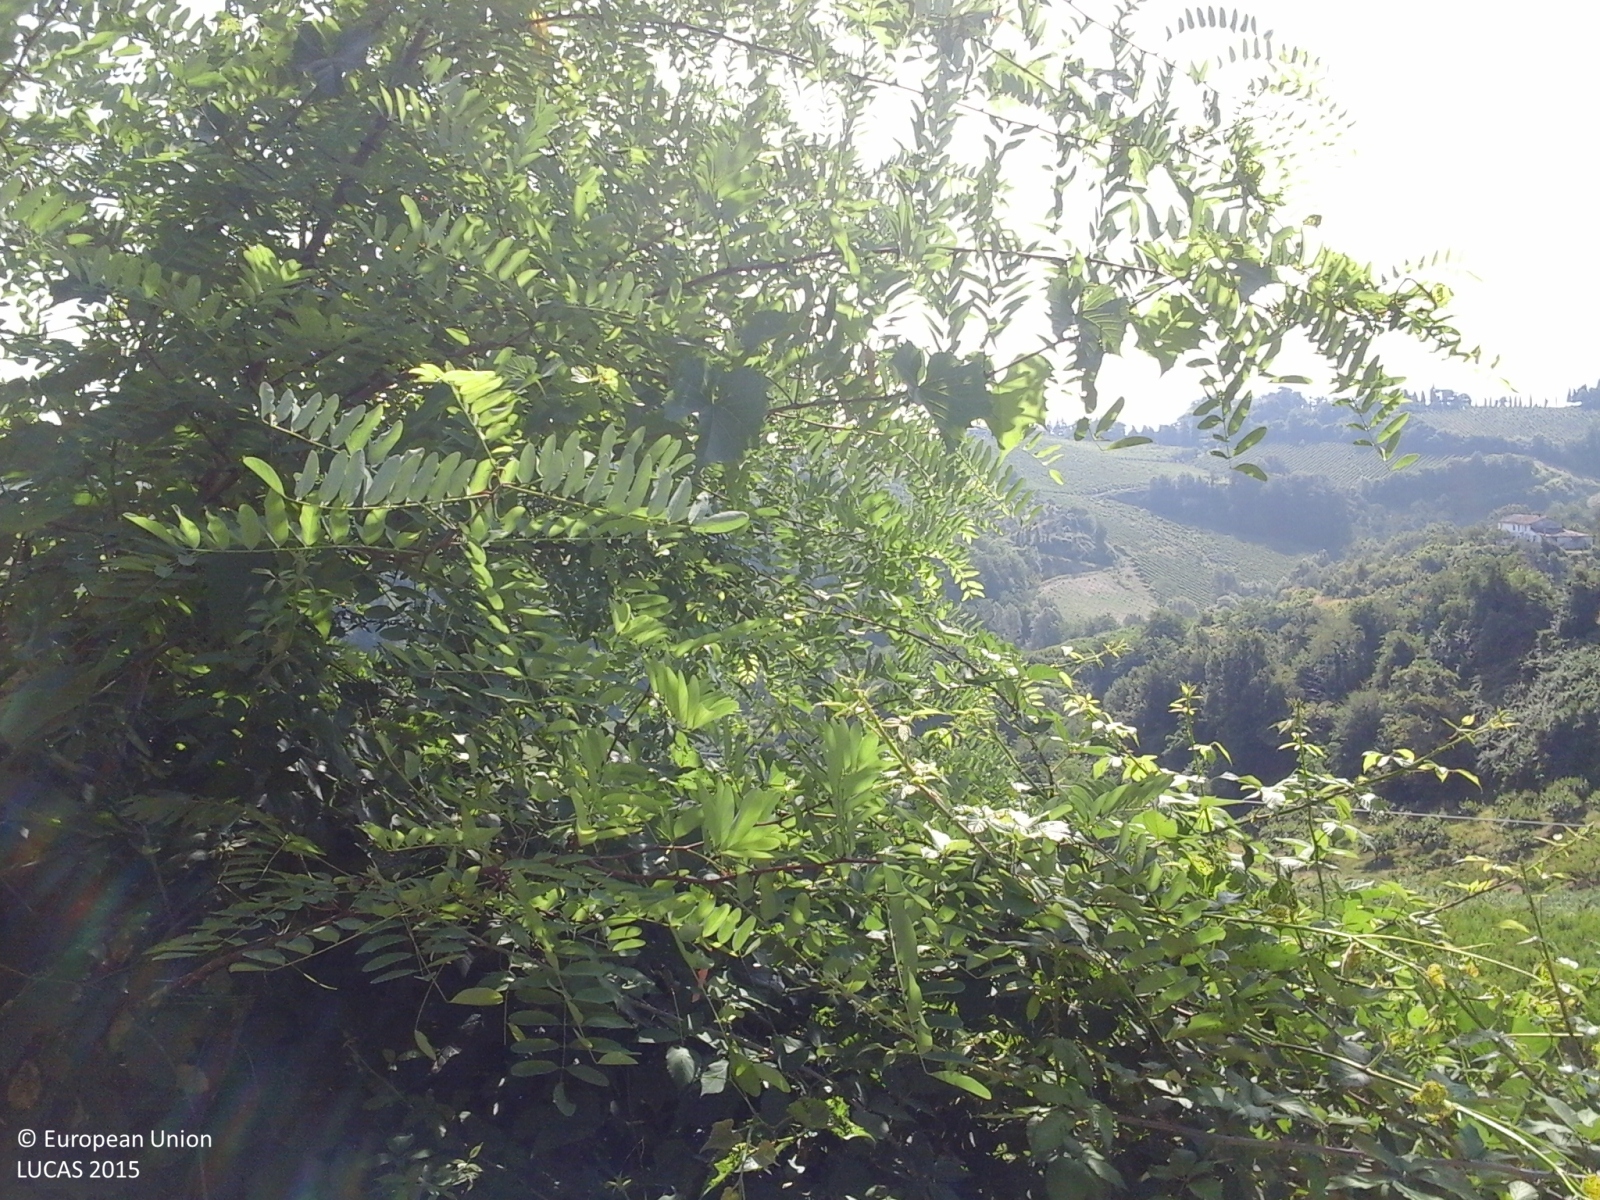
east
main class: Shrubland
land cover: Shrubland with sparse tree cover
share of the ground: > 75 %
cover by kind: shrubs 95 %, coniferous forest trees 5 %
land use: Abandoned areas
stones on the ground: < 10 %
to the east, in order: Shrubland with sparse tree cover; Grass margins; Tracks; Grass margins; Electric lines; Tracks; Vineyards; Tracks; Other fruit trees and berries; Tracks; Broadleaved woodland
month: July
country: IT
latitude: 44.0915
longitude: 12.2555
